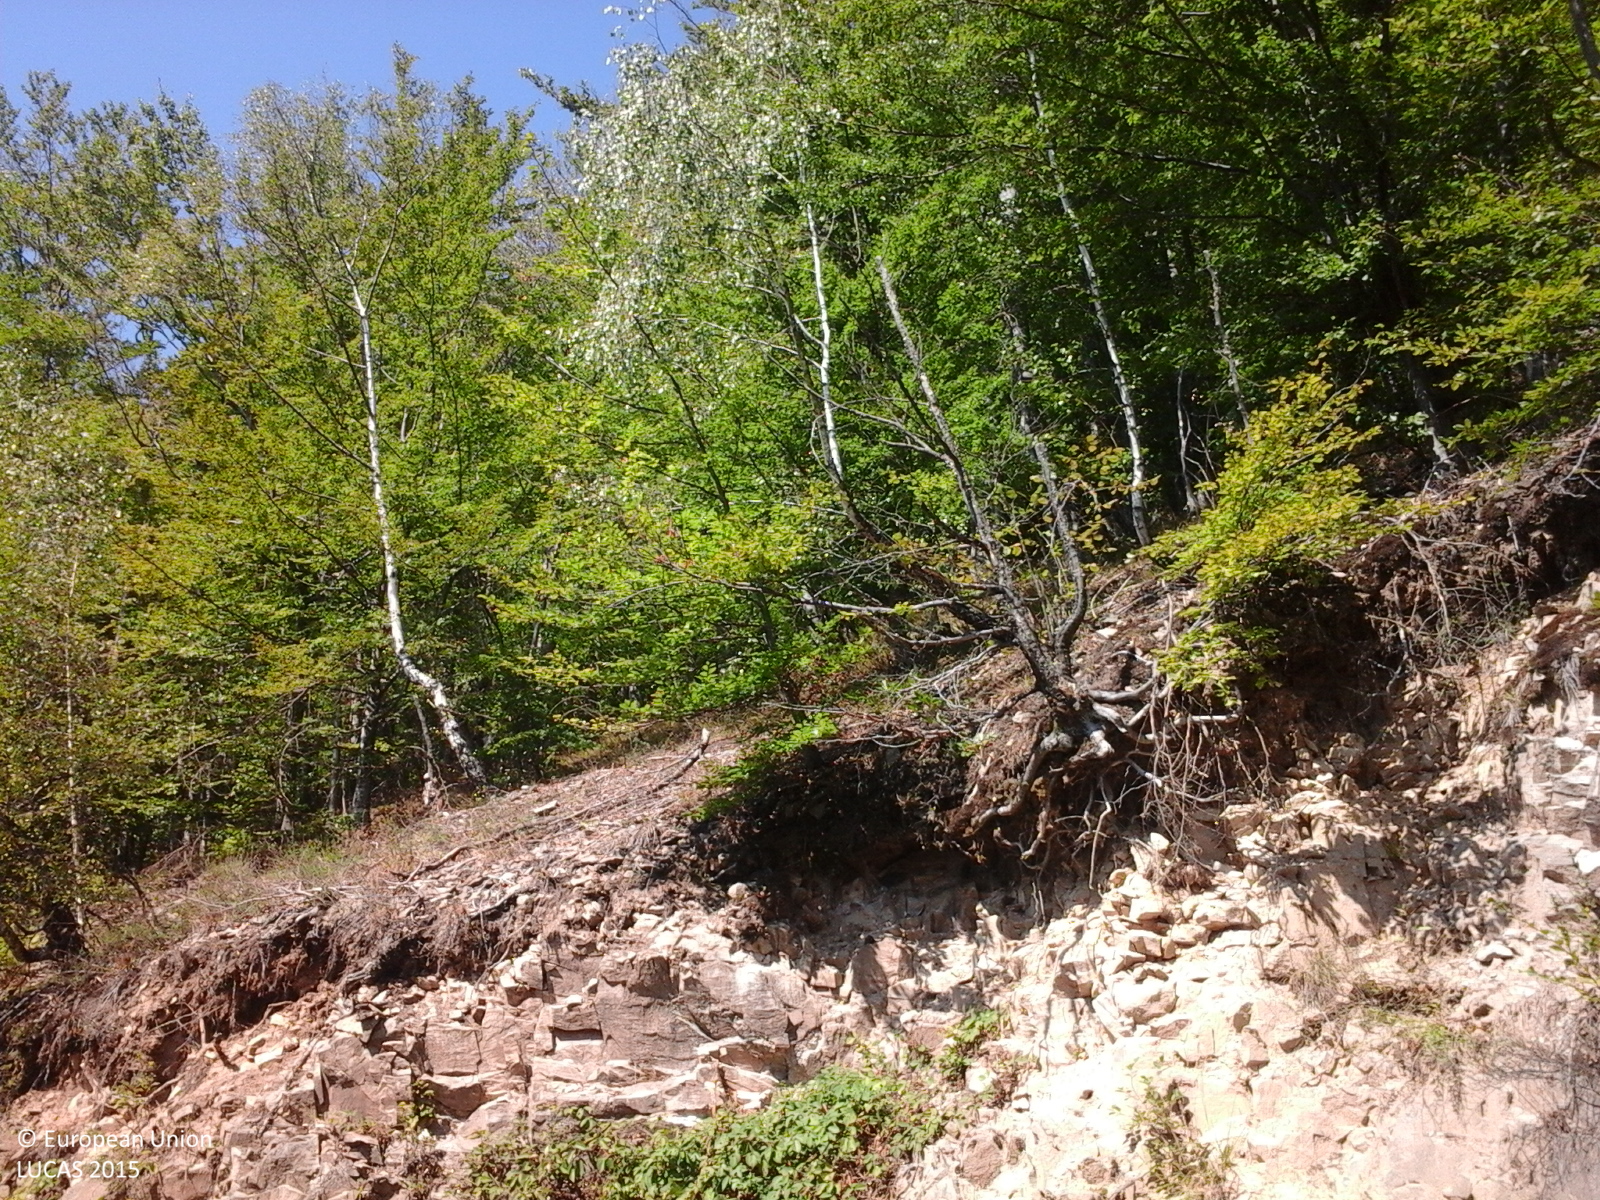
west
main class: Woodland
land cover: Broadleaved woodland
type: beech forest
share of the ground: > 75 %
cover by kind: broadleaved forest trees 100 %
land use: Forestry
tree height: > 5 m
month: September
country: RO
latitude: 46.6817
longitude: 22.5651
